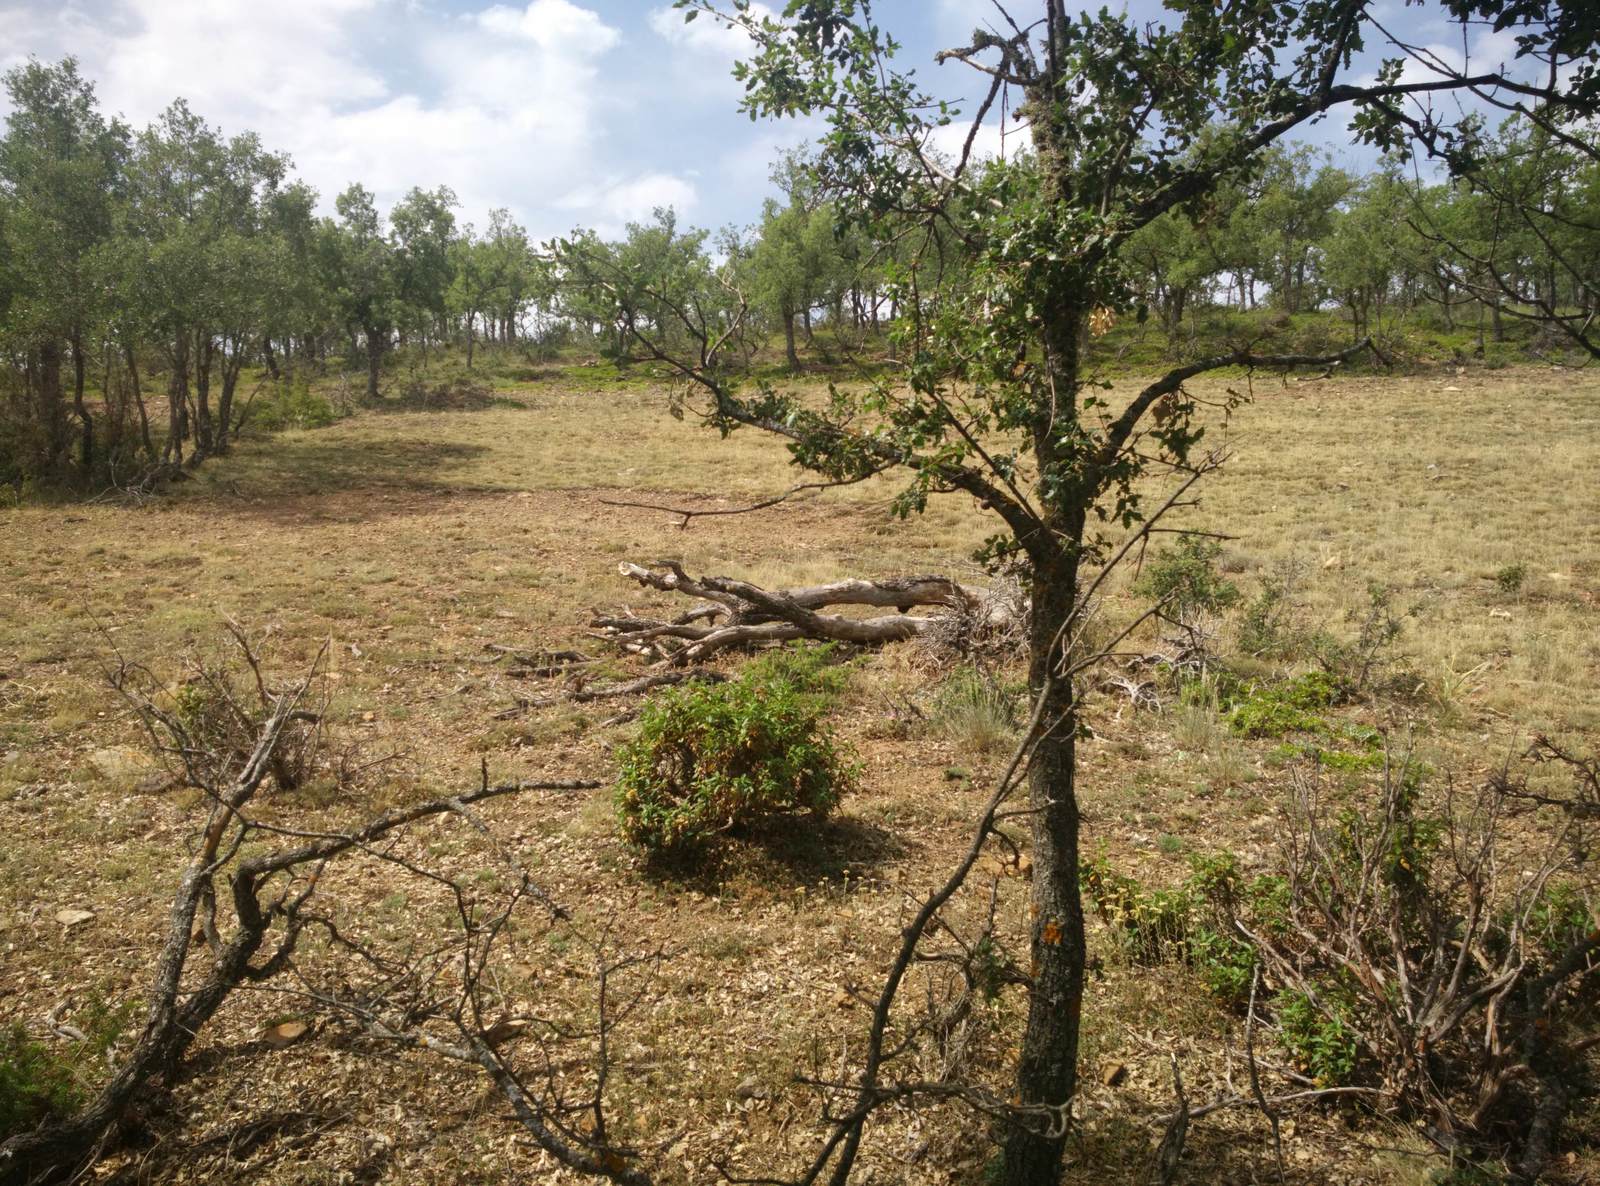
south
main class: Grassland
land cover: Grassland with sparse tree/shrub cover
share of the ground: 50 - 75 %
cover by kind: herbaceous plants 60 %, unconsolidated bare surface 30 %, broadleaved forest trees 5 %, shrubs 5 %
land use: Semi-natural and natural areas not in use
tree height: > 5 m
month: July
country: ES
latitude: 40.9362
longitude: -1.9843
